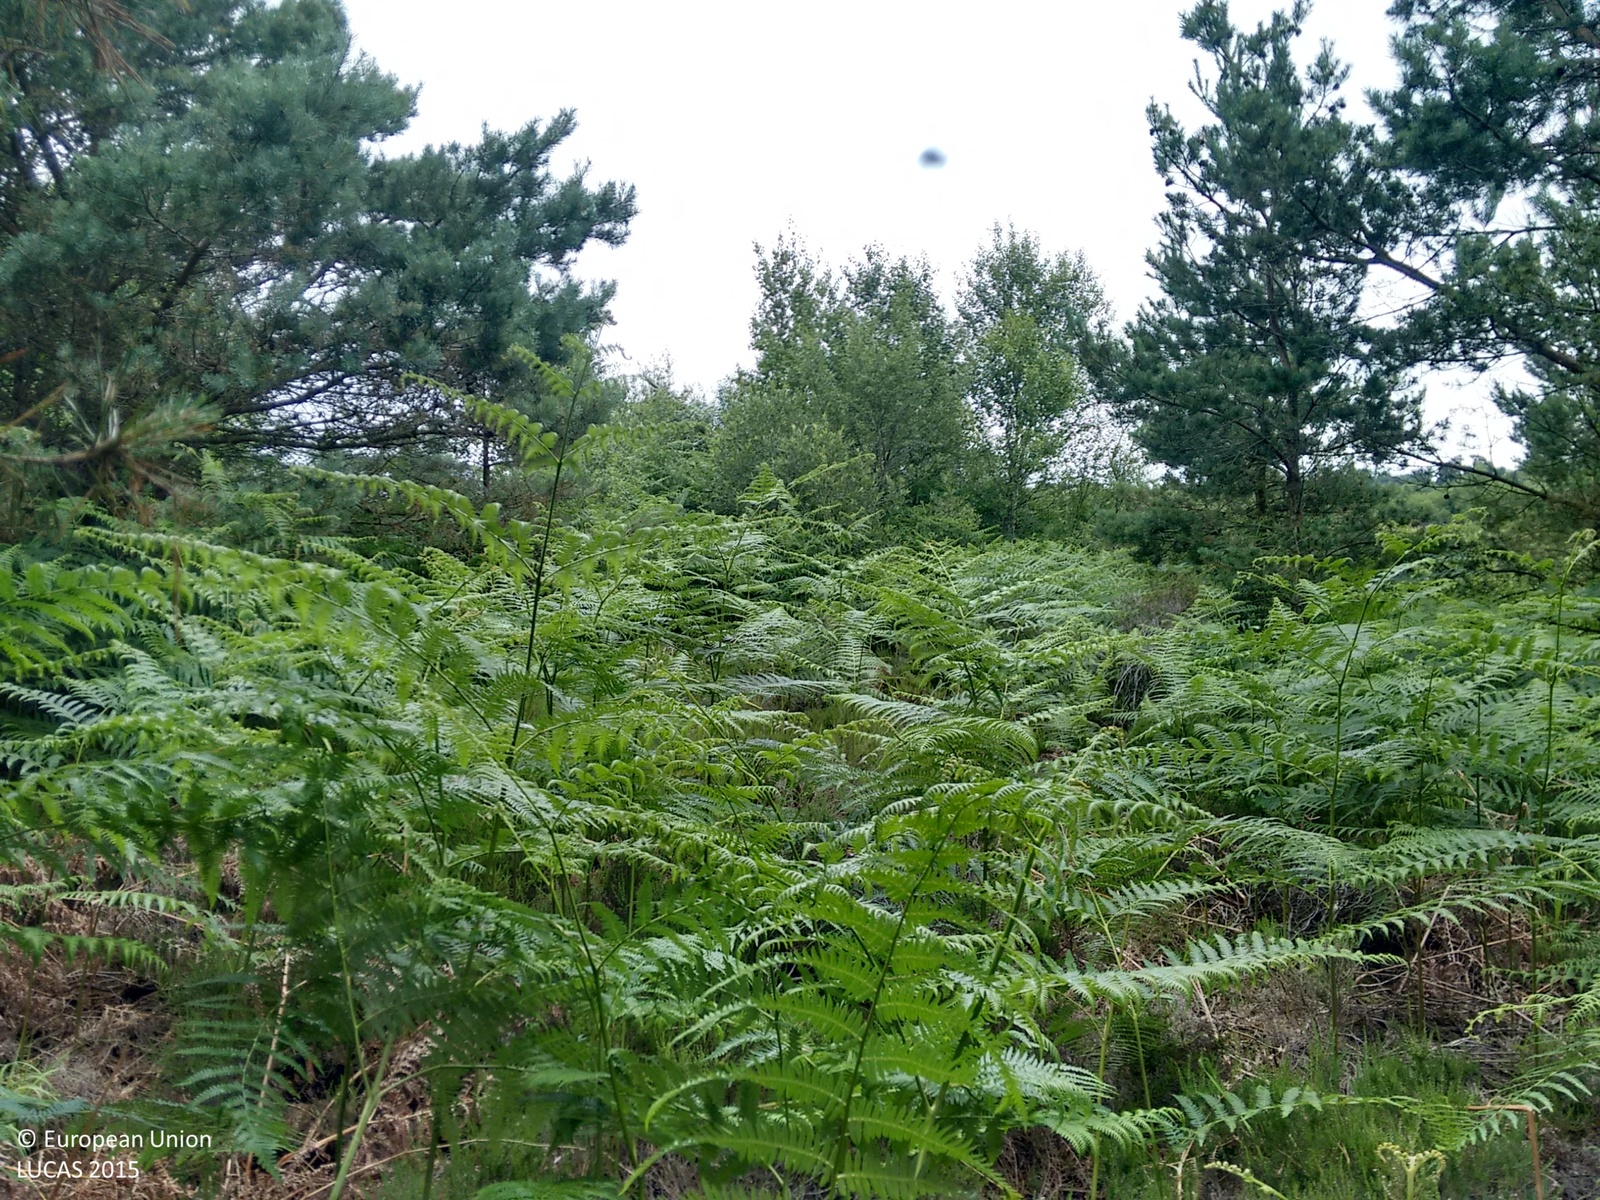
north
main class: Woodland
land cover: Pine dominated mixed woodland
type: hemiboreal forest and nemoral coniferous forest and mixed broadleaved-coniferous forest
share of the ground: 50 - 75 %
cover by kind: coniferous forest trees 60 %, broadleaved forest trees 20 %, shrubs 20 %
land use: Semi-natural and natural areas not in use
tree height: < 5 m
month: July
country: IE
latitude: 52.6781
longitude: -7.6617
